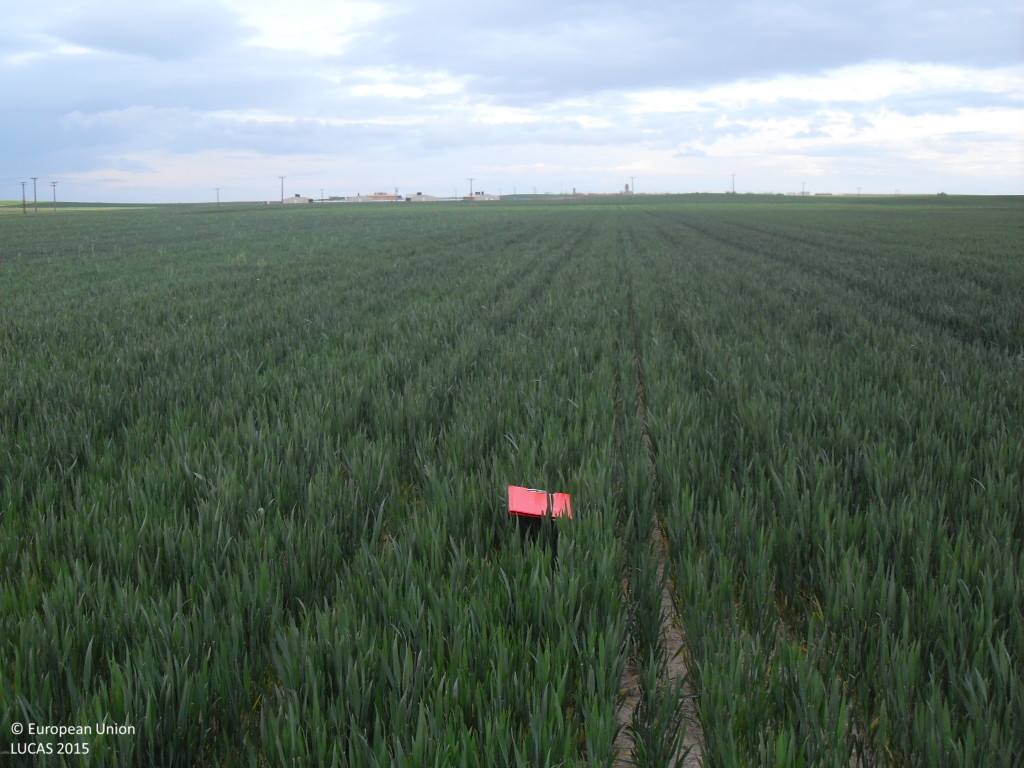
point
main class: Cropland
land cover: Common wheat
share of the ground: > 75 %
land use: Agriculture (excluding fallow land and kitchen gardens)
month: April
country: ES
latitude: 40.9994
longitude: -5.2271
